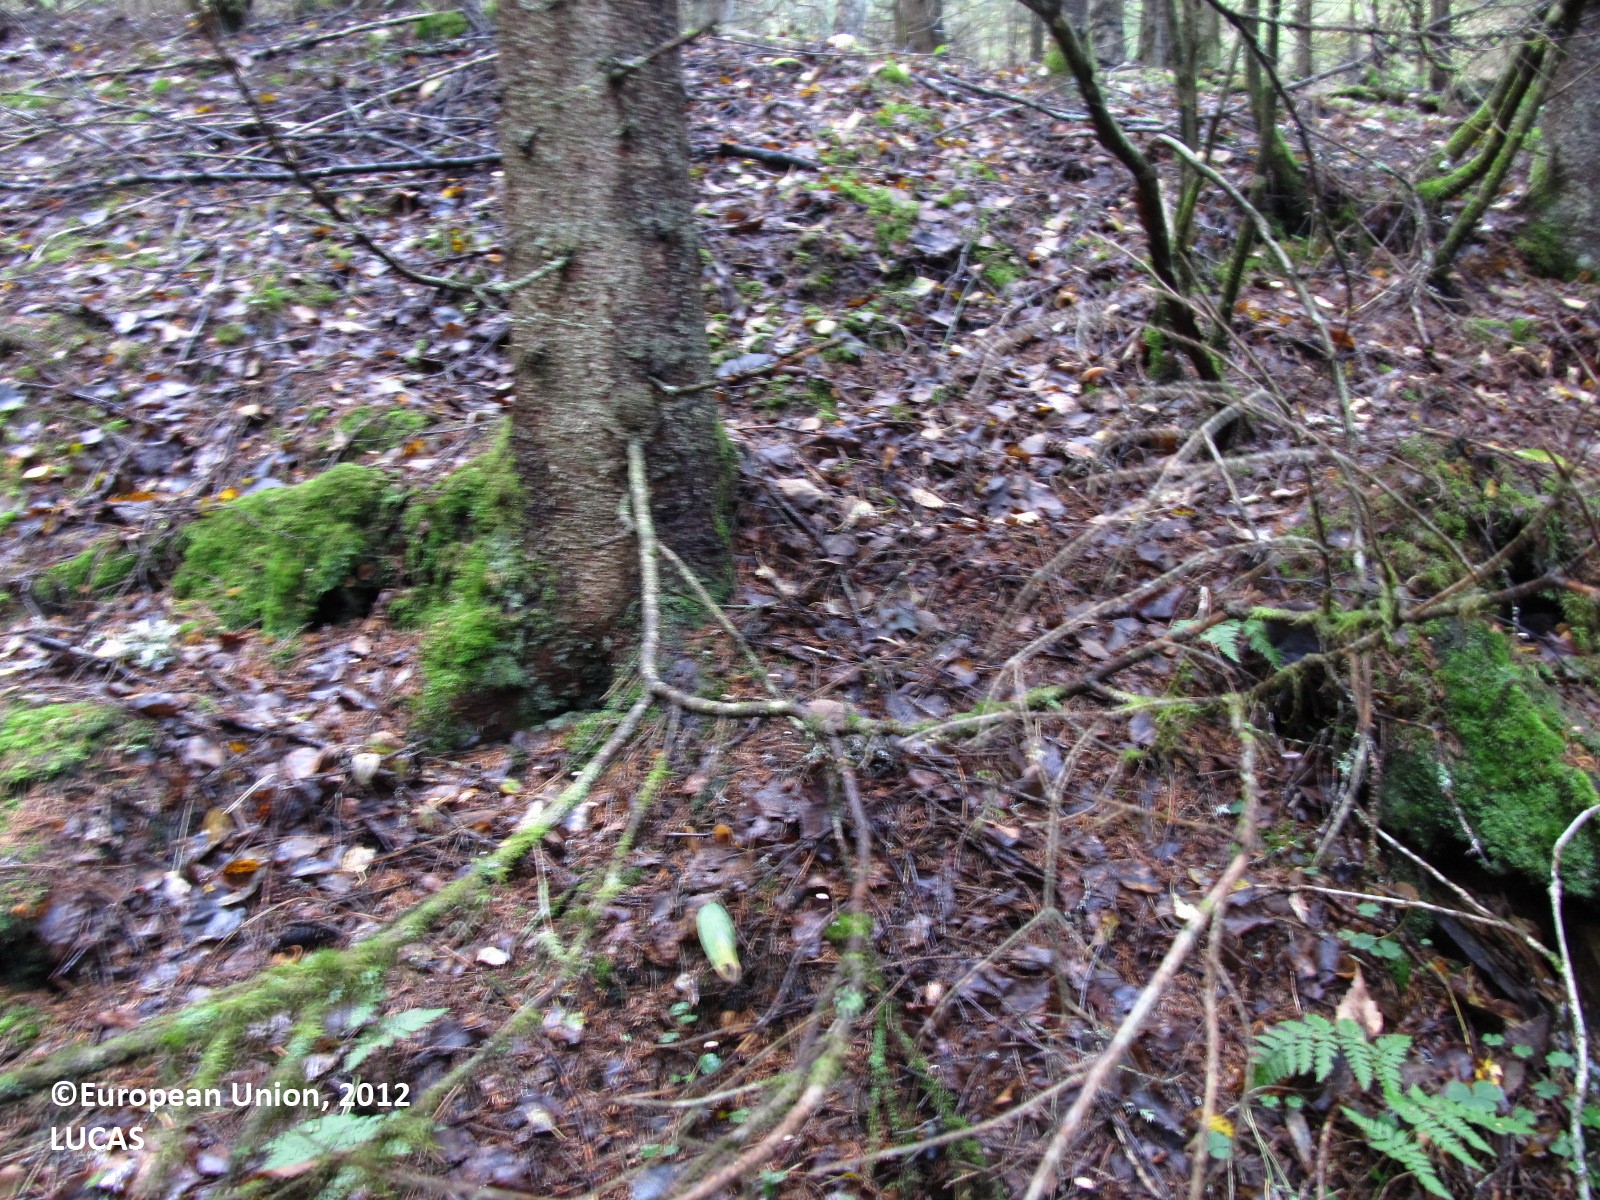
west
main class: Woodland
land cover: Spruce dominated coniferous woodland
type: boreal forest
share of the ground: > 75 %
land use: Forestry
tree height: > 5 m
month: September
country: FI
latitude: 63.2365
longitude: 28.3607
